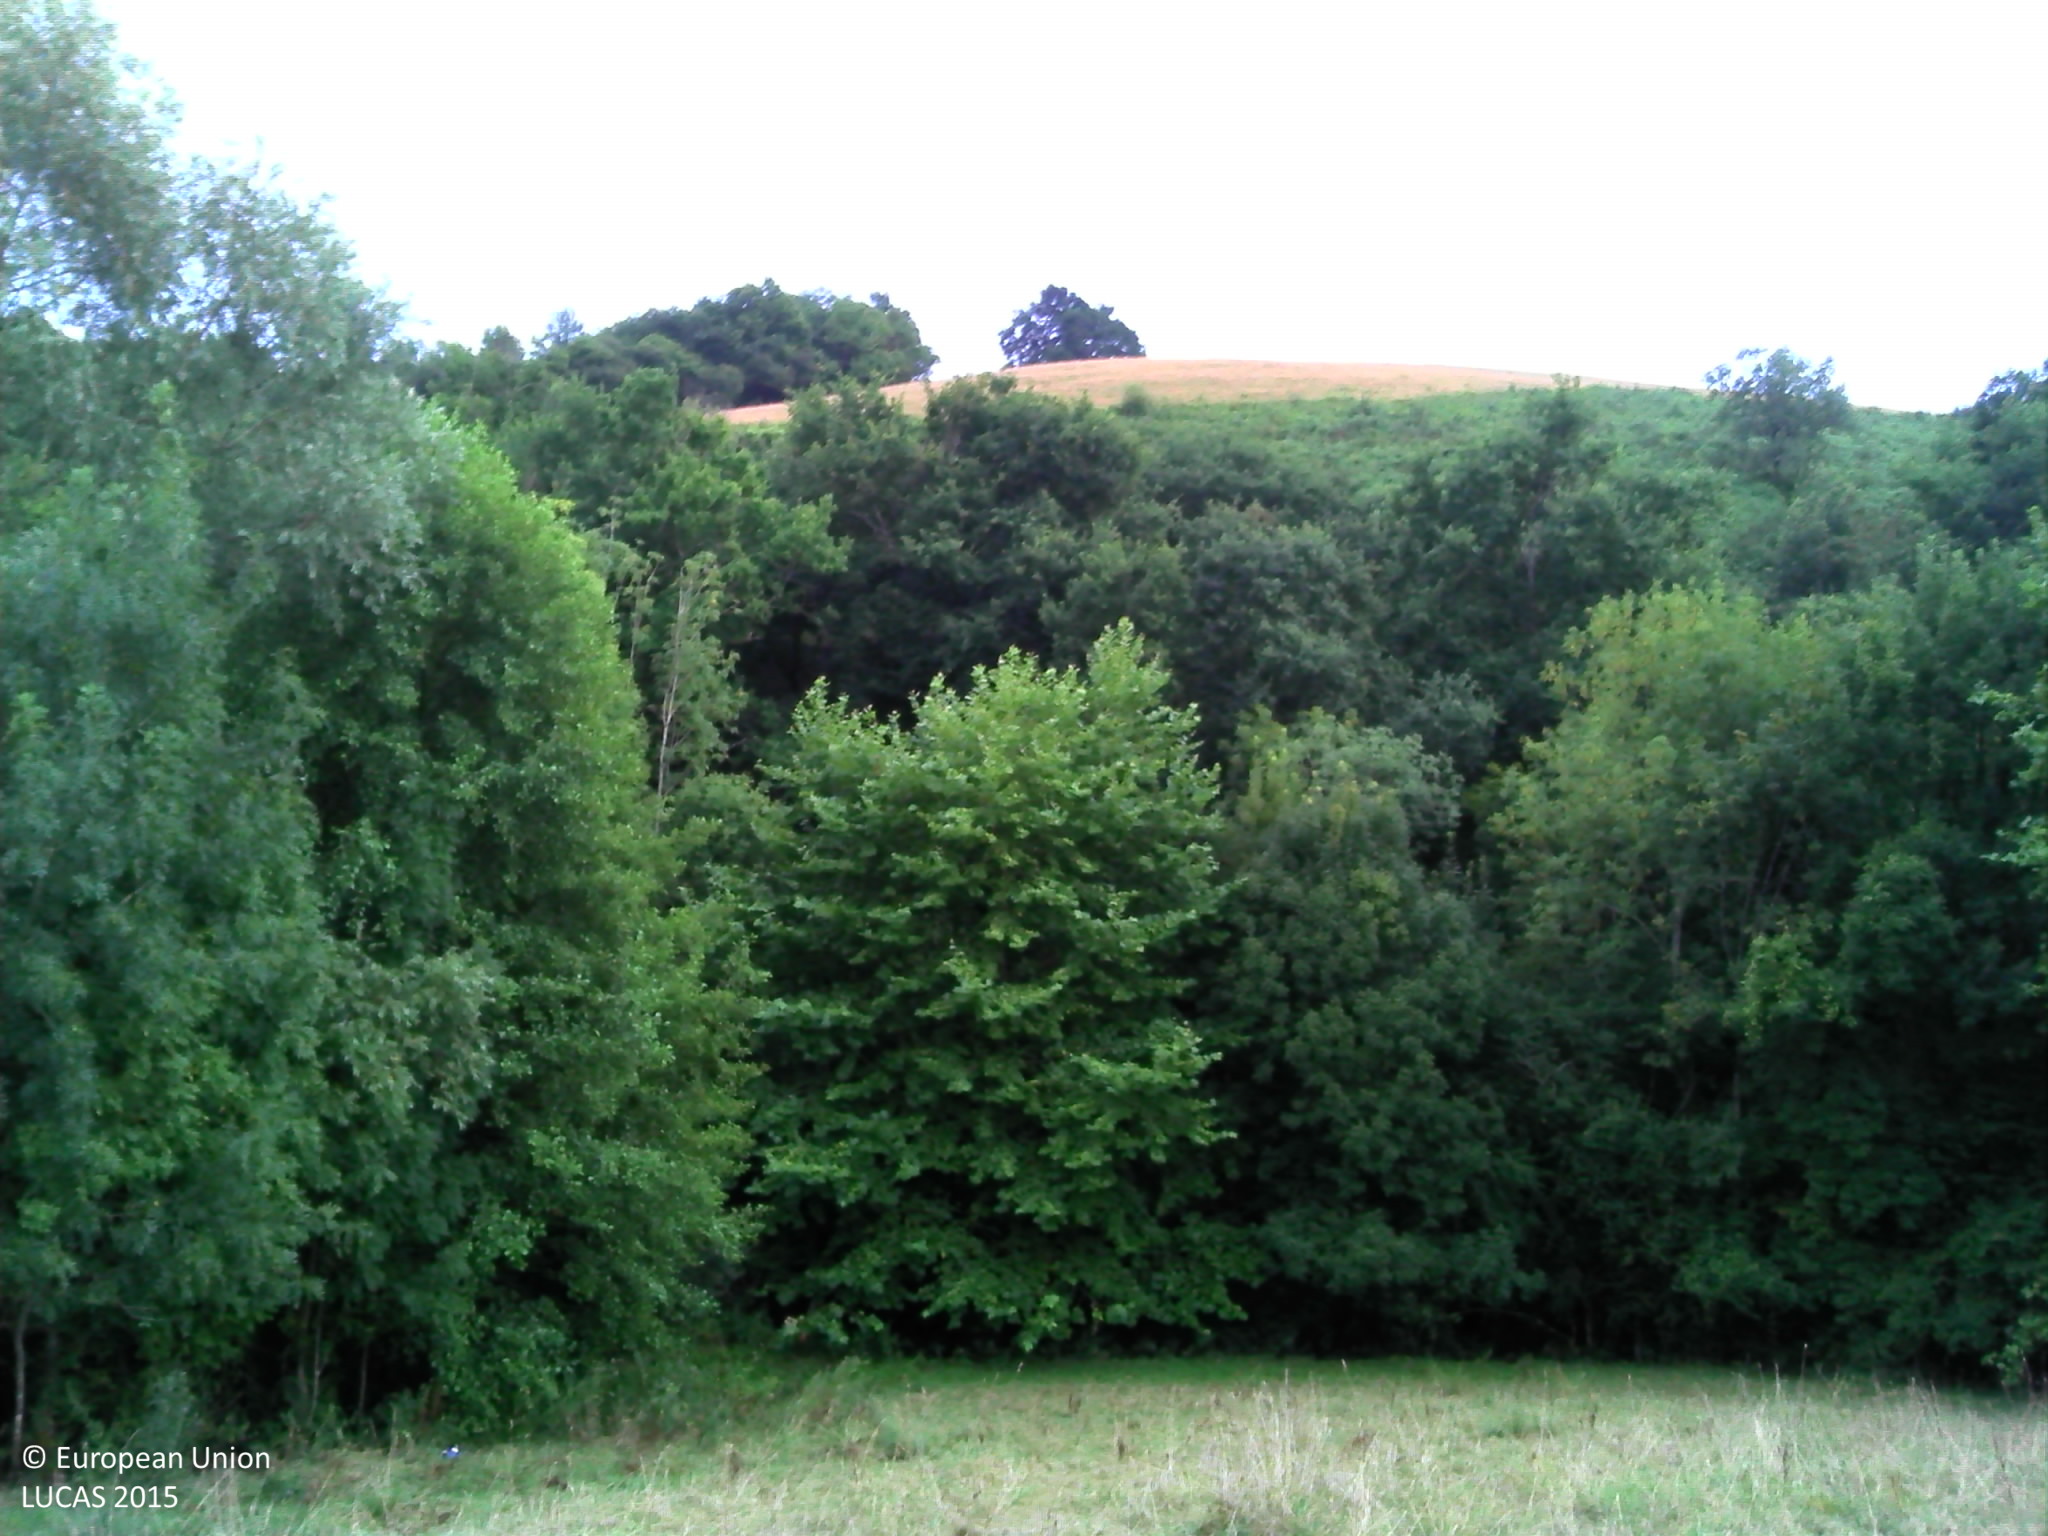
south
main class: Grassland
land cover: Grassland without tree/shrub cover
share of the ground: > 75 %
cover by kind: herbaceous plants 100 %
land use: Agriculture (excluding fallow land and kitchen gardens)
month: August
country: FR
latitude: 43.3951
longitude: -1.2128
